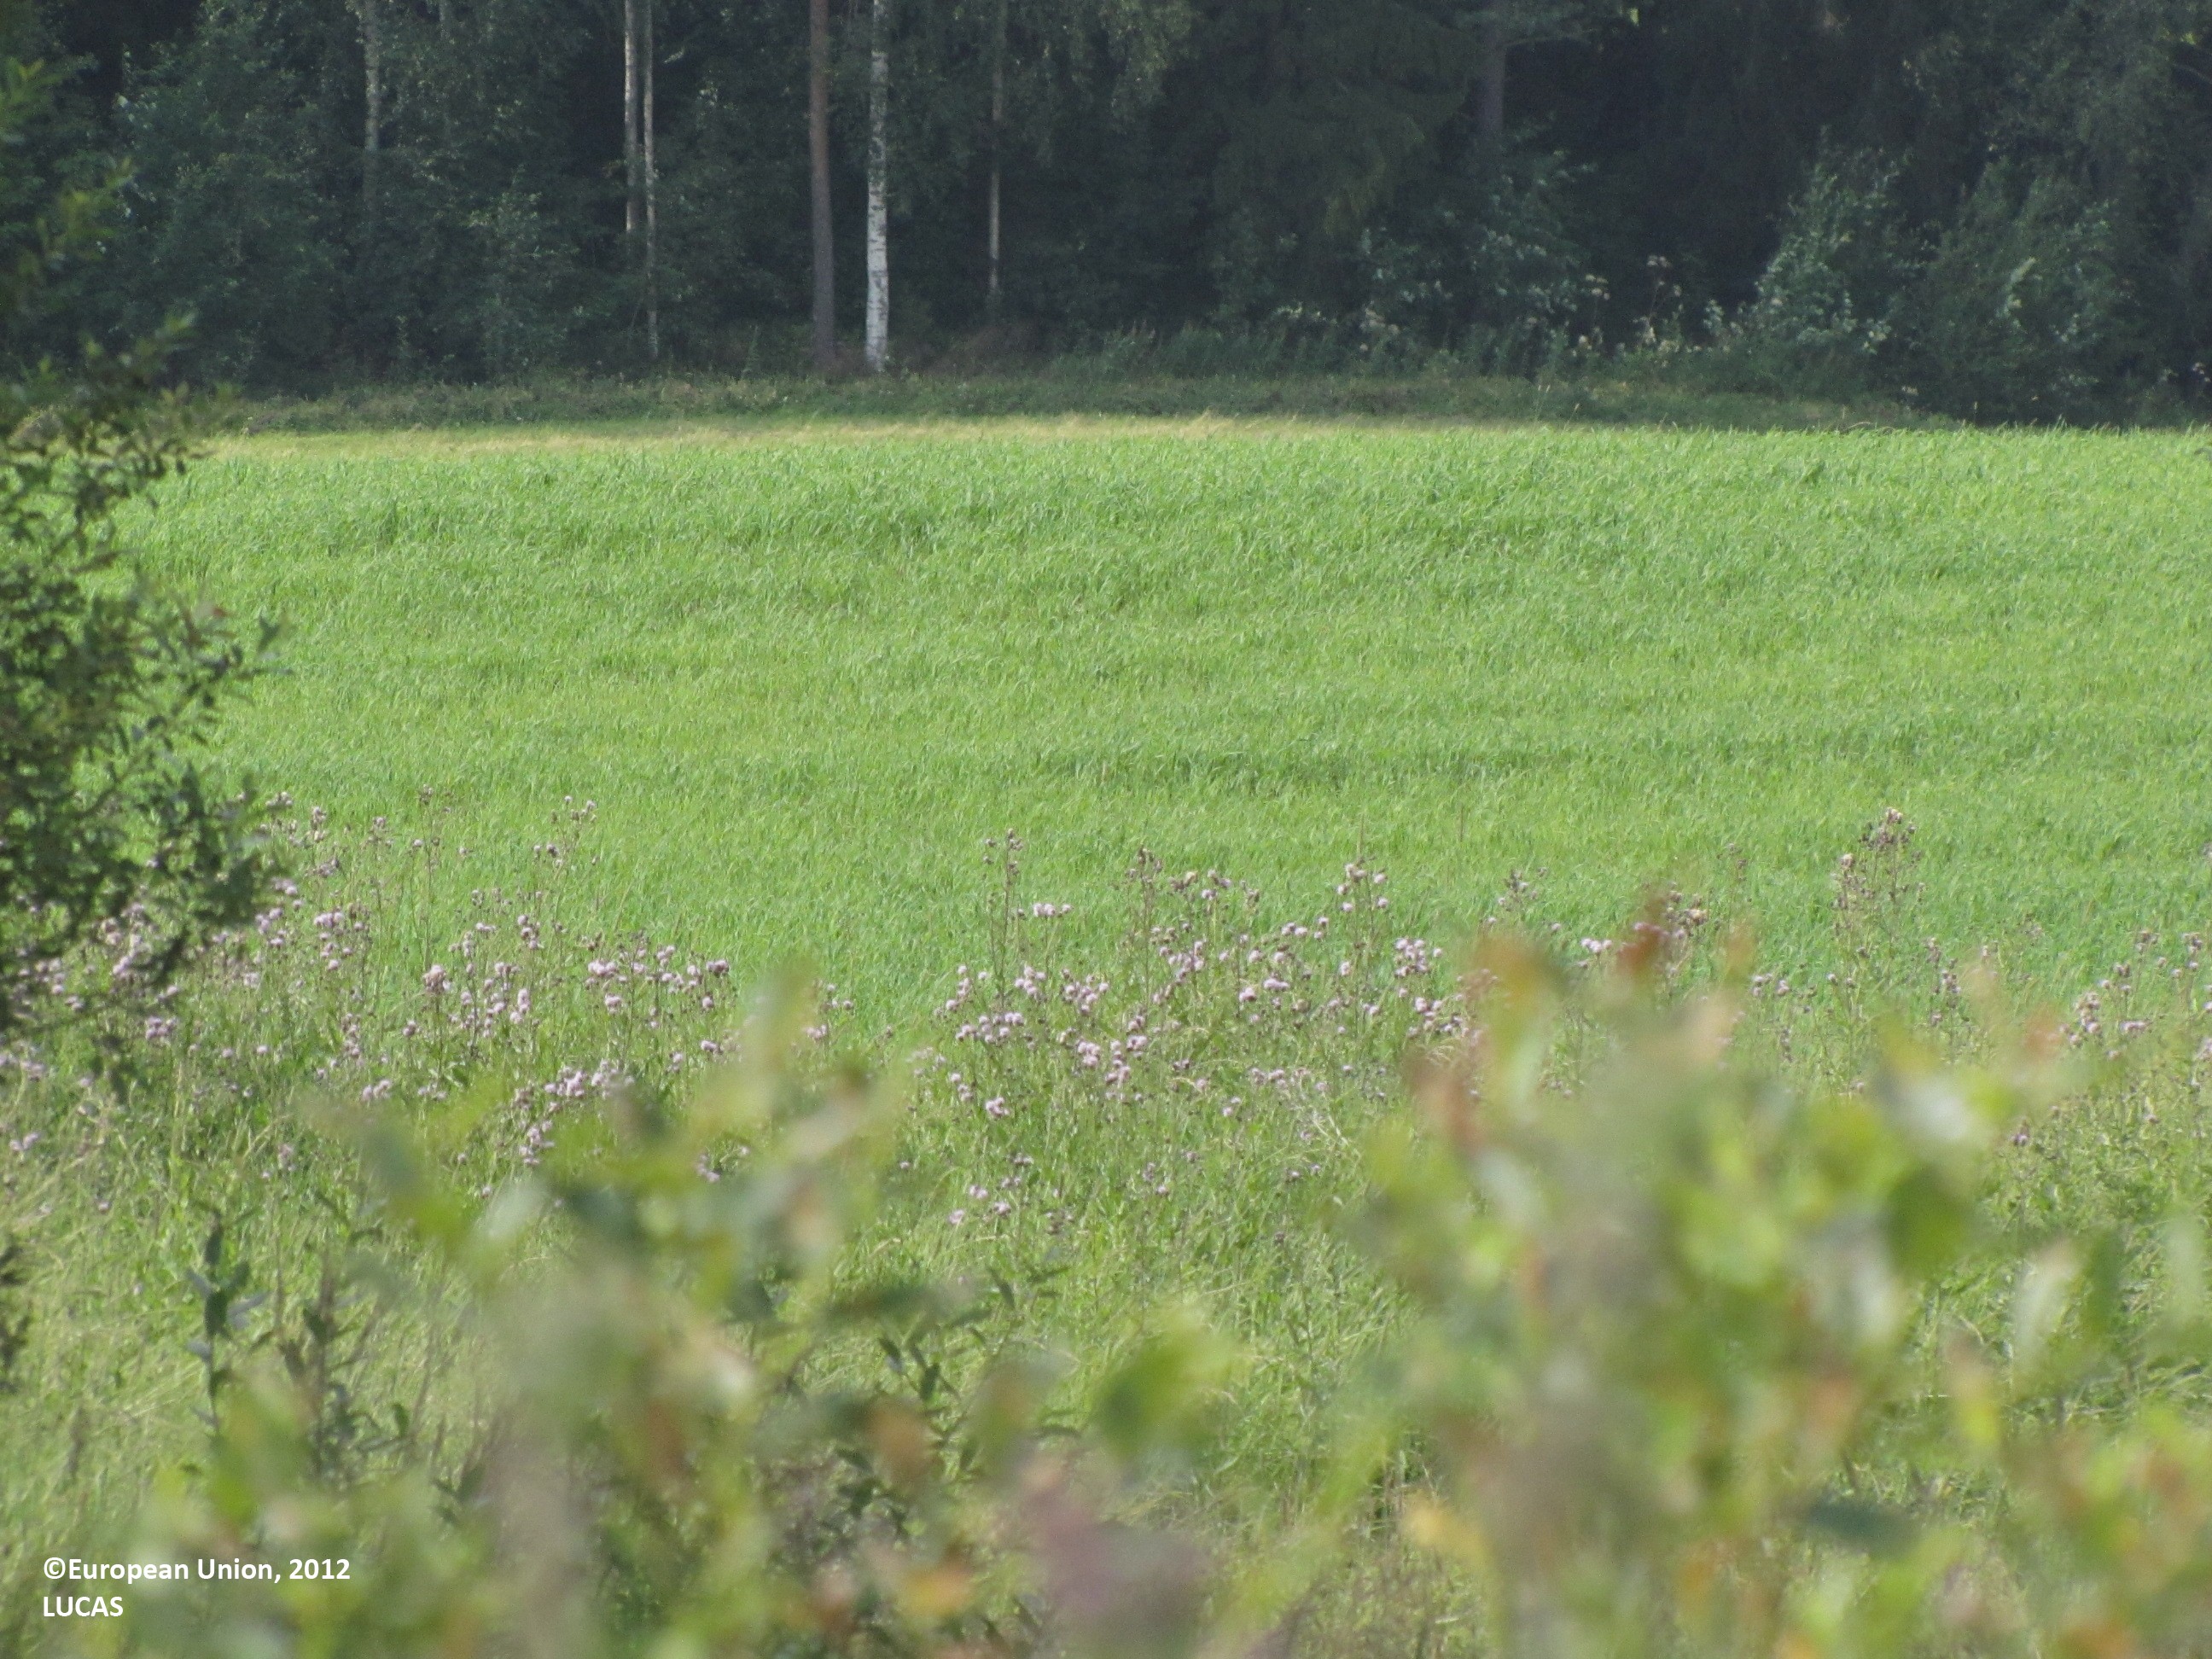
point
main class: Cropland
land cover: Temporary grasslands
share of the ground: > 75 %
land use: Agriculture (excluding fallow land and kitchen gardens)
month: July
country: FI
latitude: 62.0061
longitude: 23.0349
